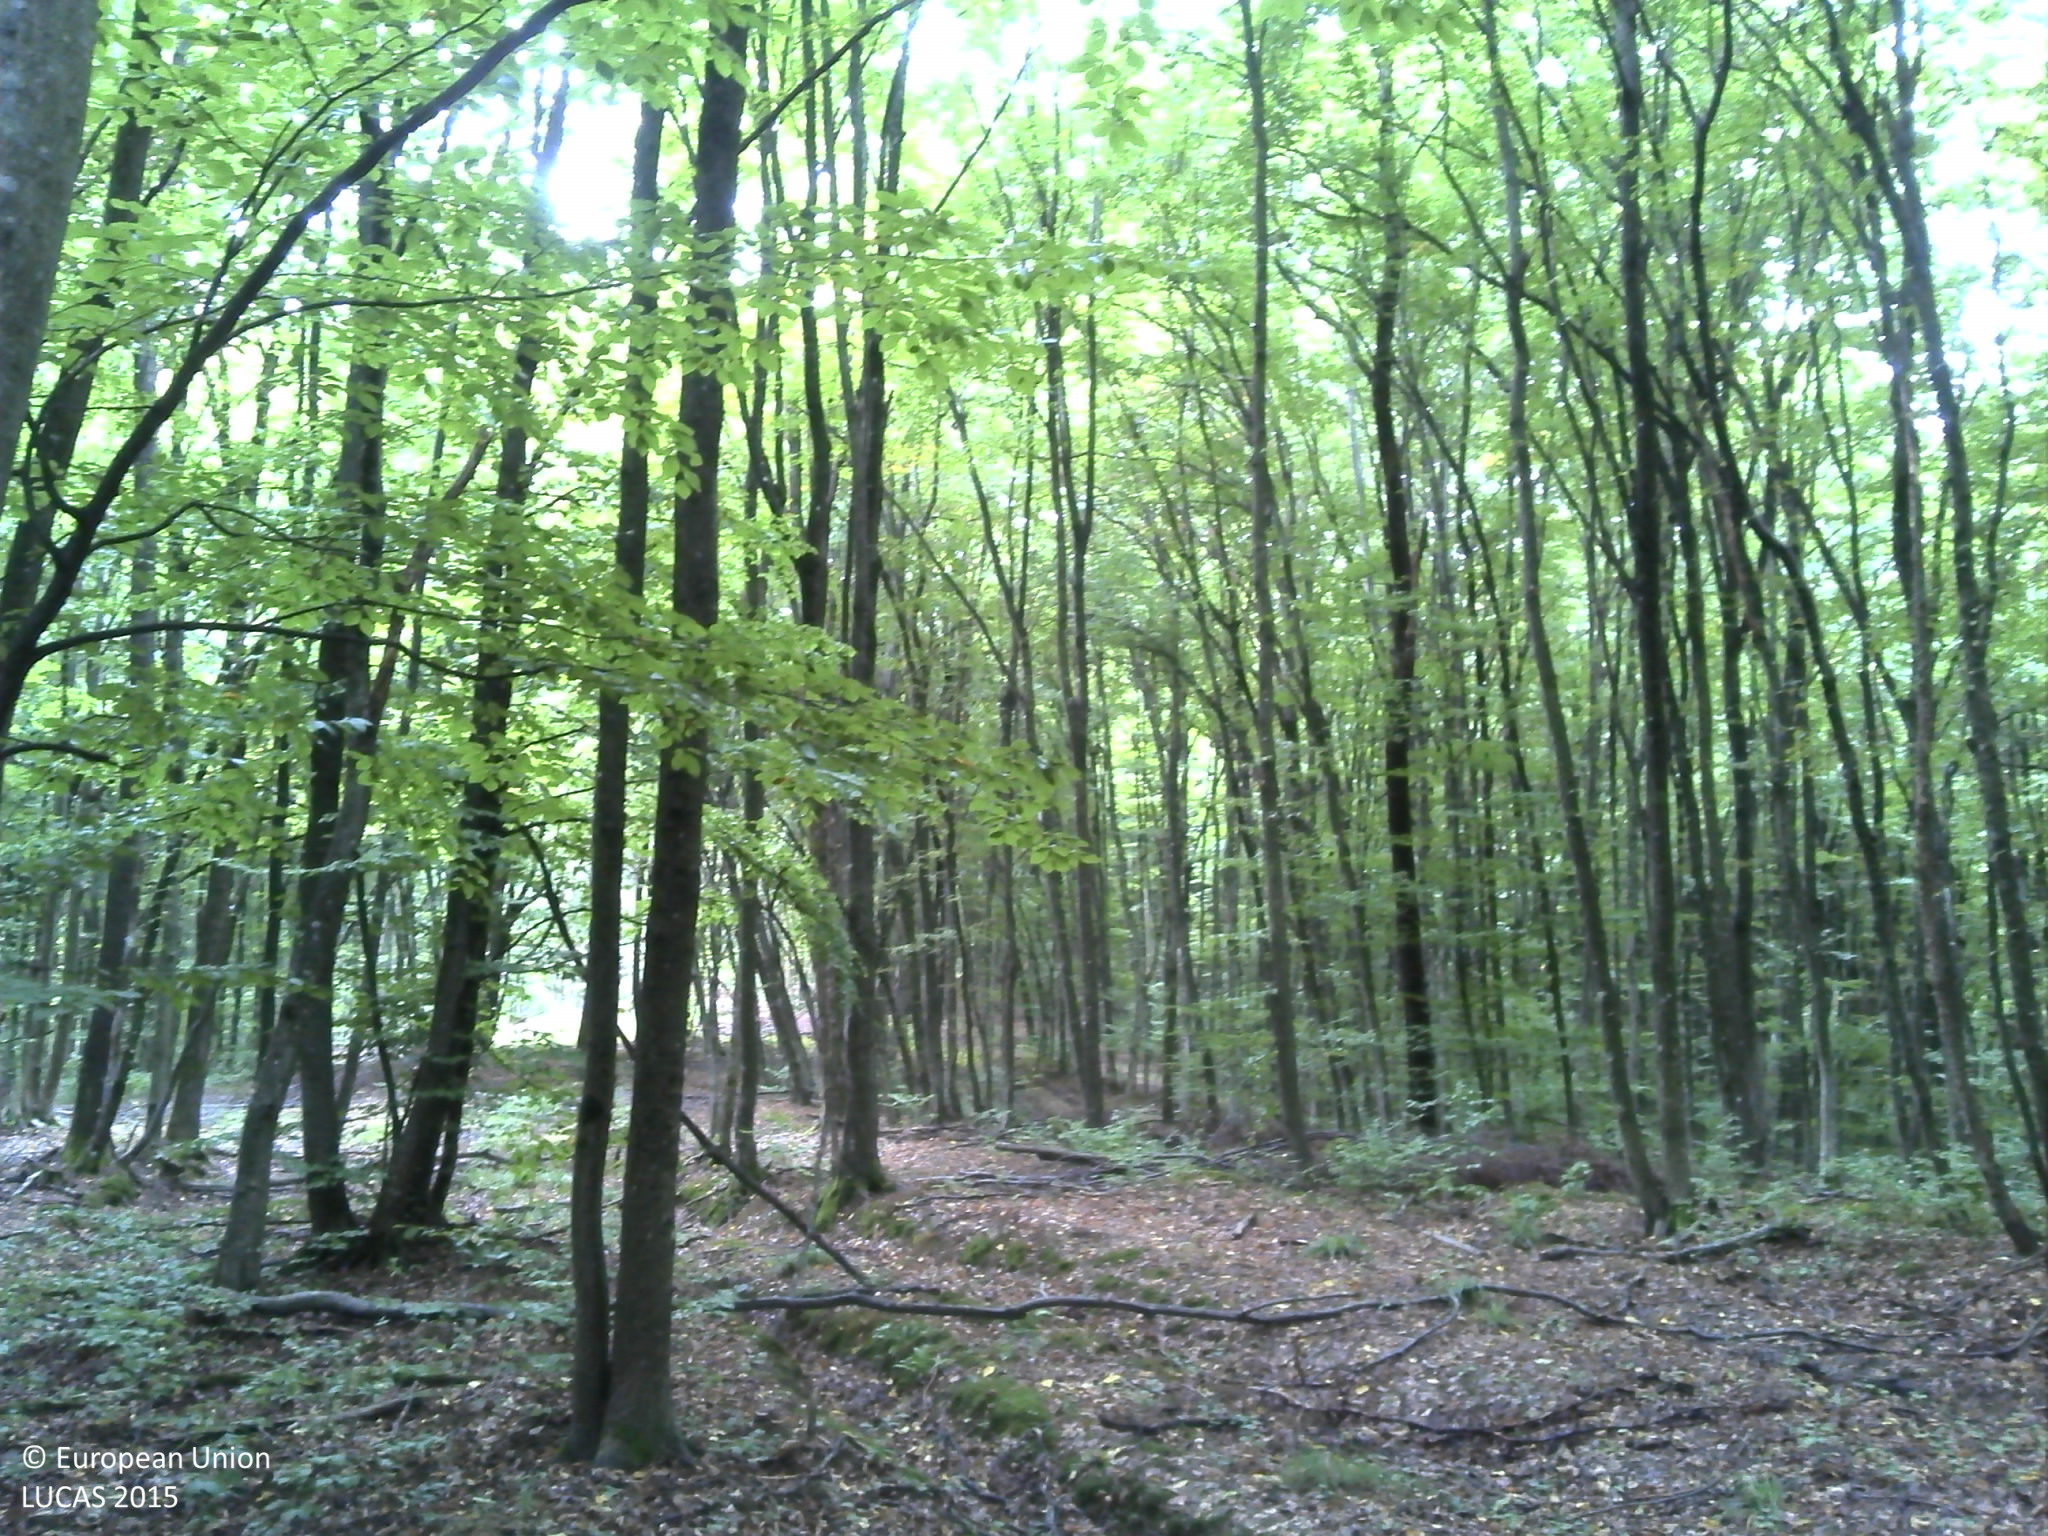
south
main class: Woodland
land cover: Broadleaved woodland
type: beech forest
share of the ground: > 75 %
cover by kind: broadleaved forest trees 100 %
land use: Forestry
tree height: > 5 m
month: August
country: HR
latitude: 45.4056
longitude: 15.6817
